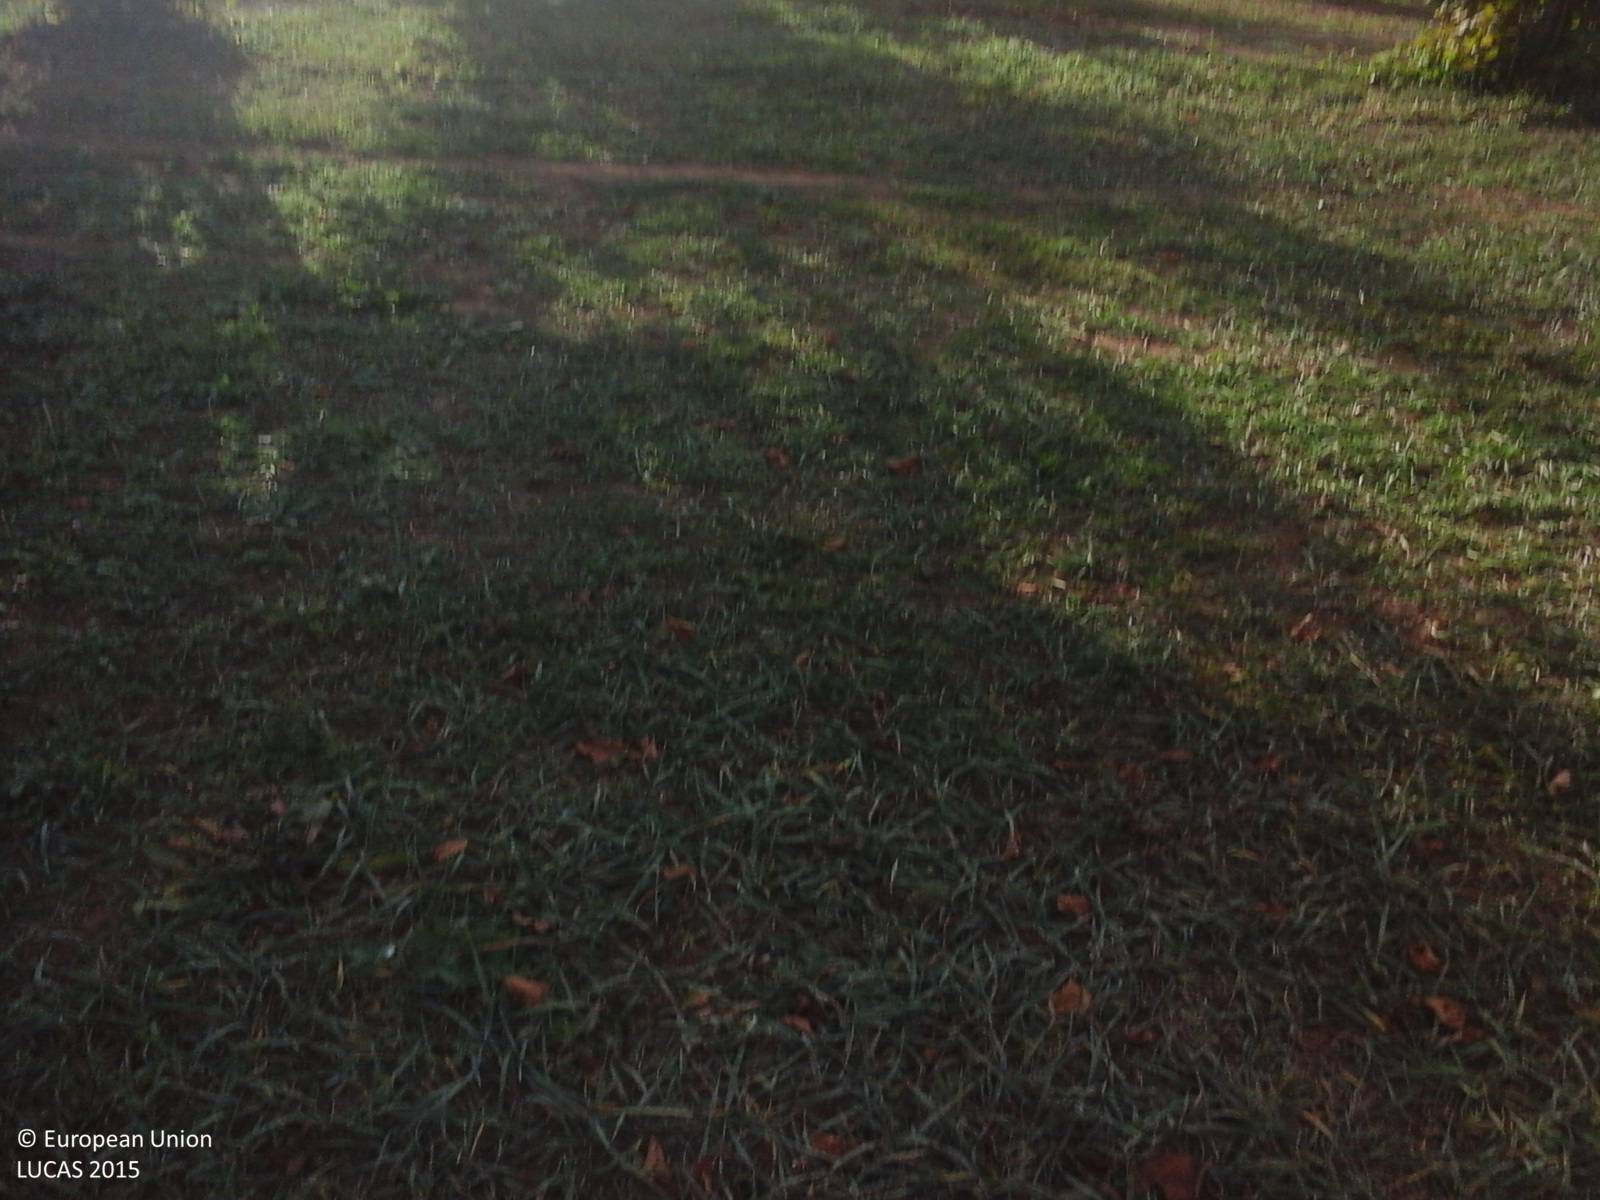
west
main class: Cropland
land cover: Nuts trees
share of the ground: > 75 %
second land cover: Spontaneously vegetated surfaces
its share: > 75 %
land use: Agriculture (excluding fallow land and kitchen gardens)
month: September
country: IT
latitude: 42.4102
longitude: 12.3373
